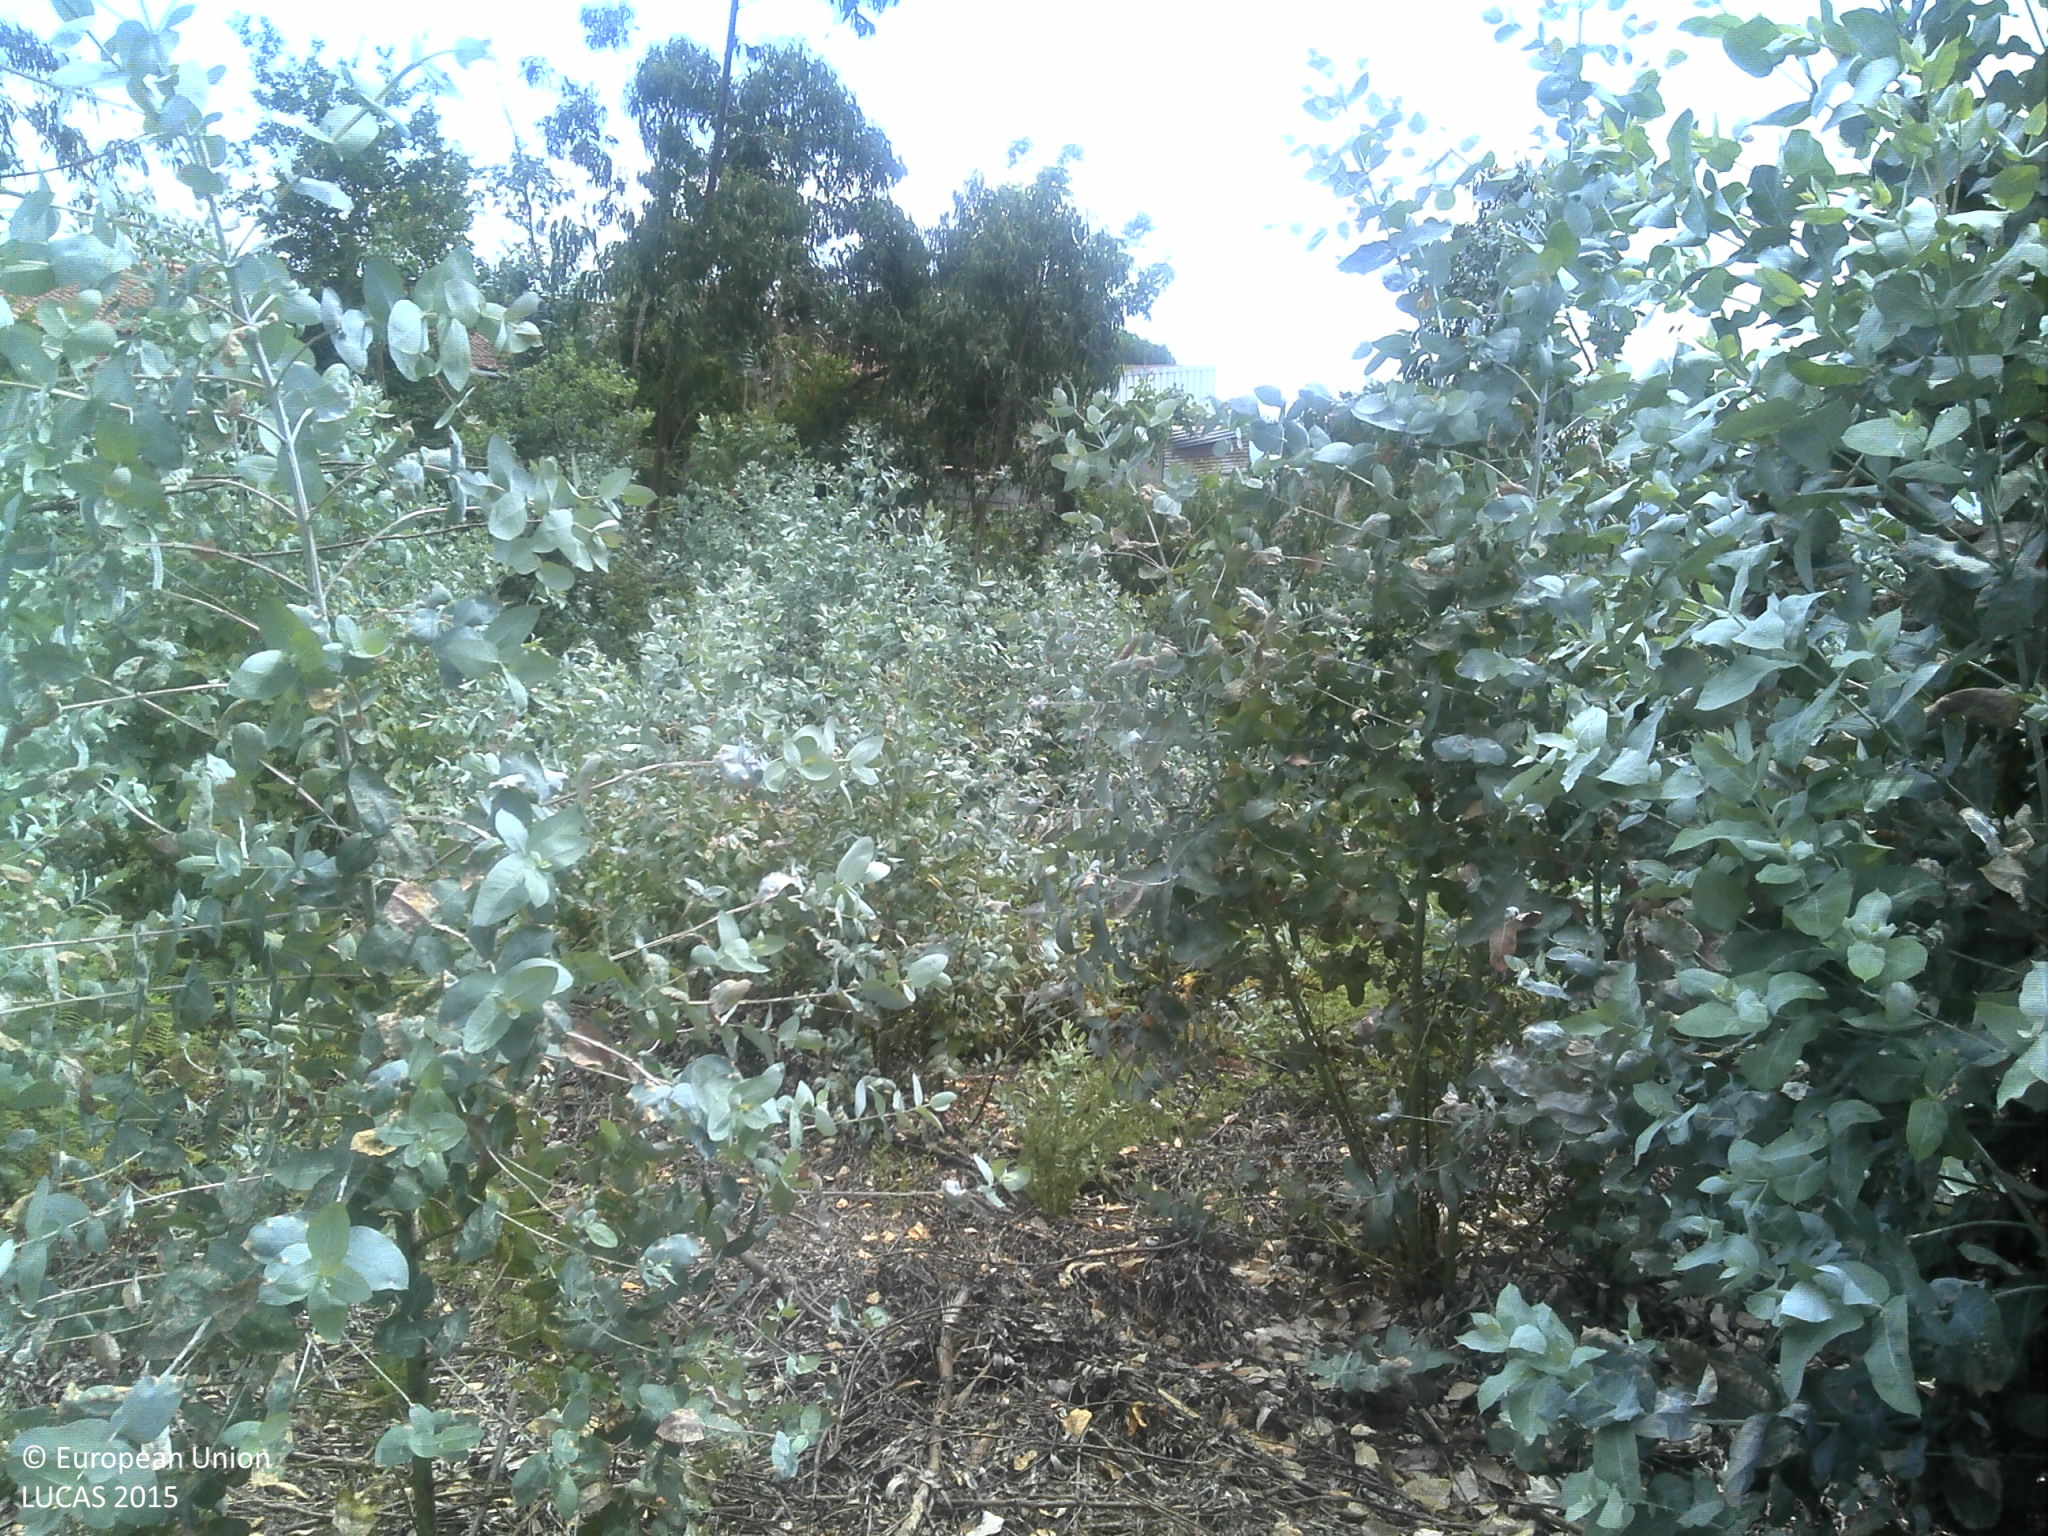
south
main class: Woodland
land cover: Broadleaved woodland
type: exotic forest
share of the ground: 25 - 50 %
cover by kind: broadleaved forest trees 50 %, unconsolidated bare surface 40 %, shrubs 10 %
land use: Forestry
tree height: < 5 m
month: June
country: PT
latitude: 41.5666
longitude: -8.5657
